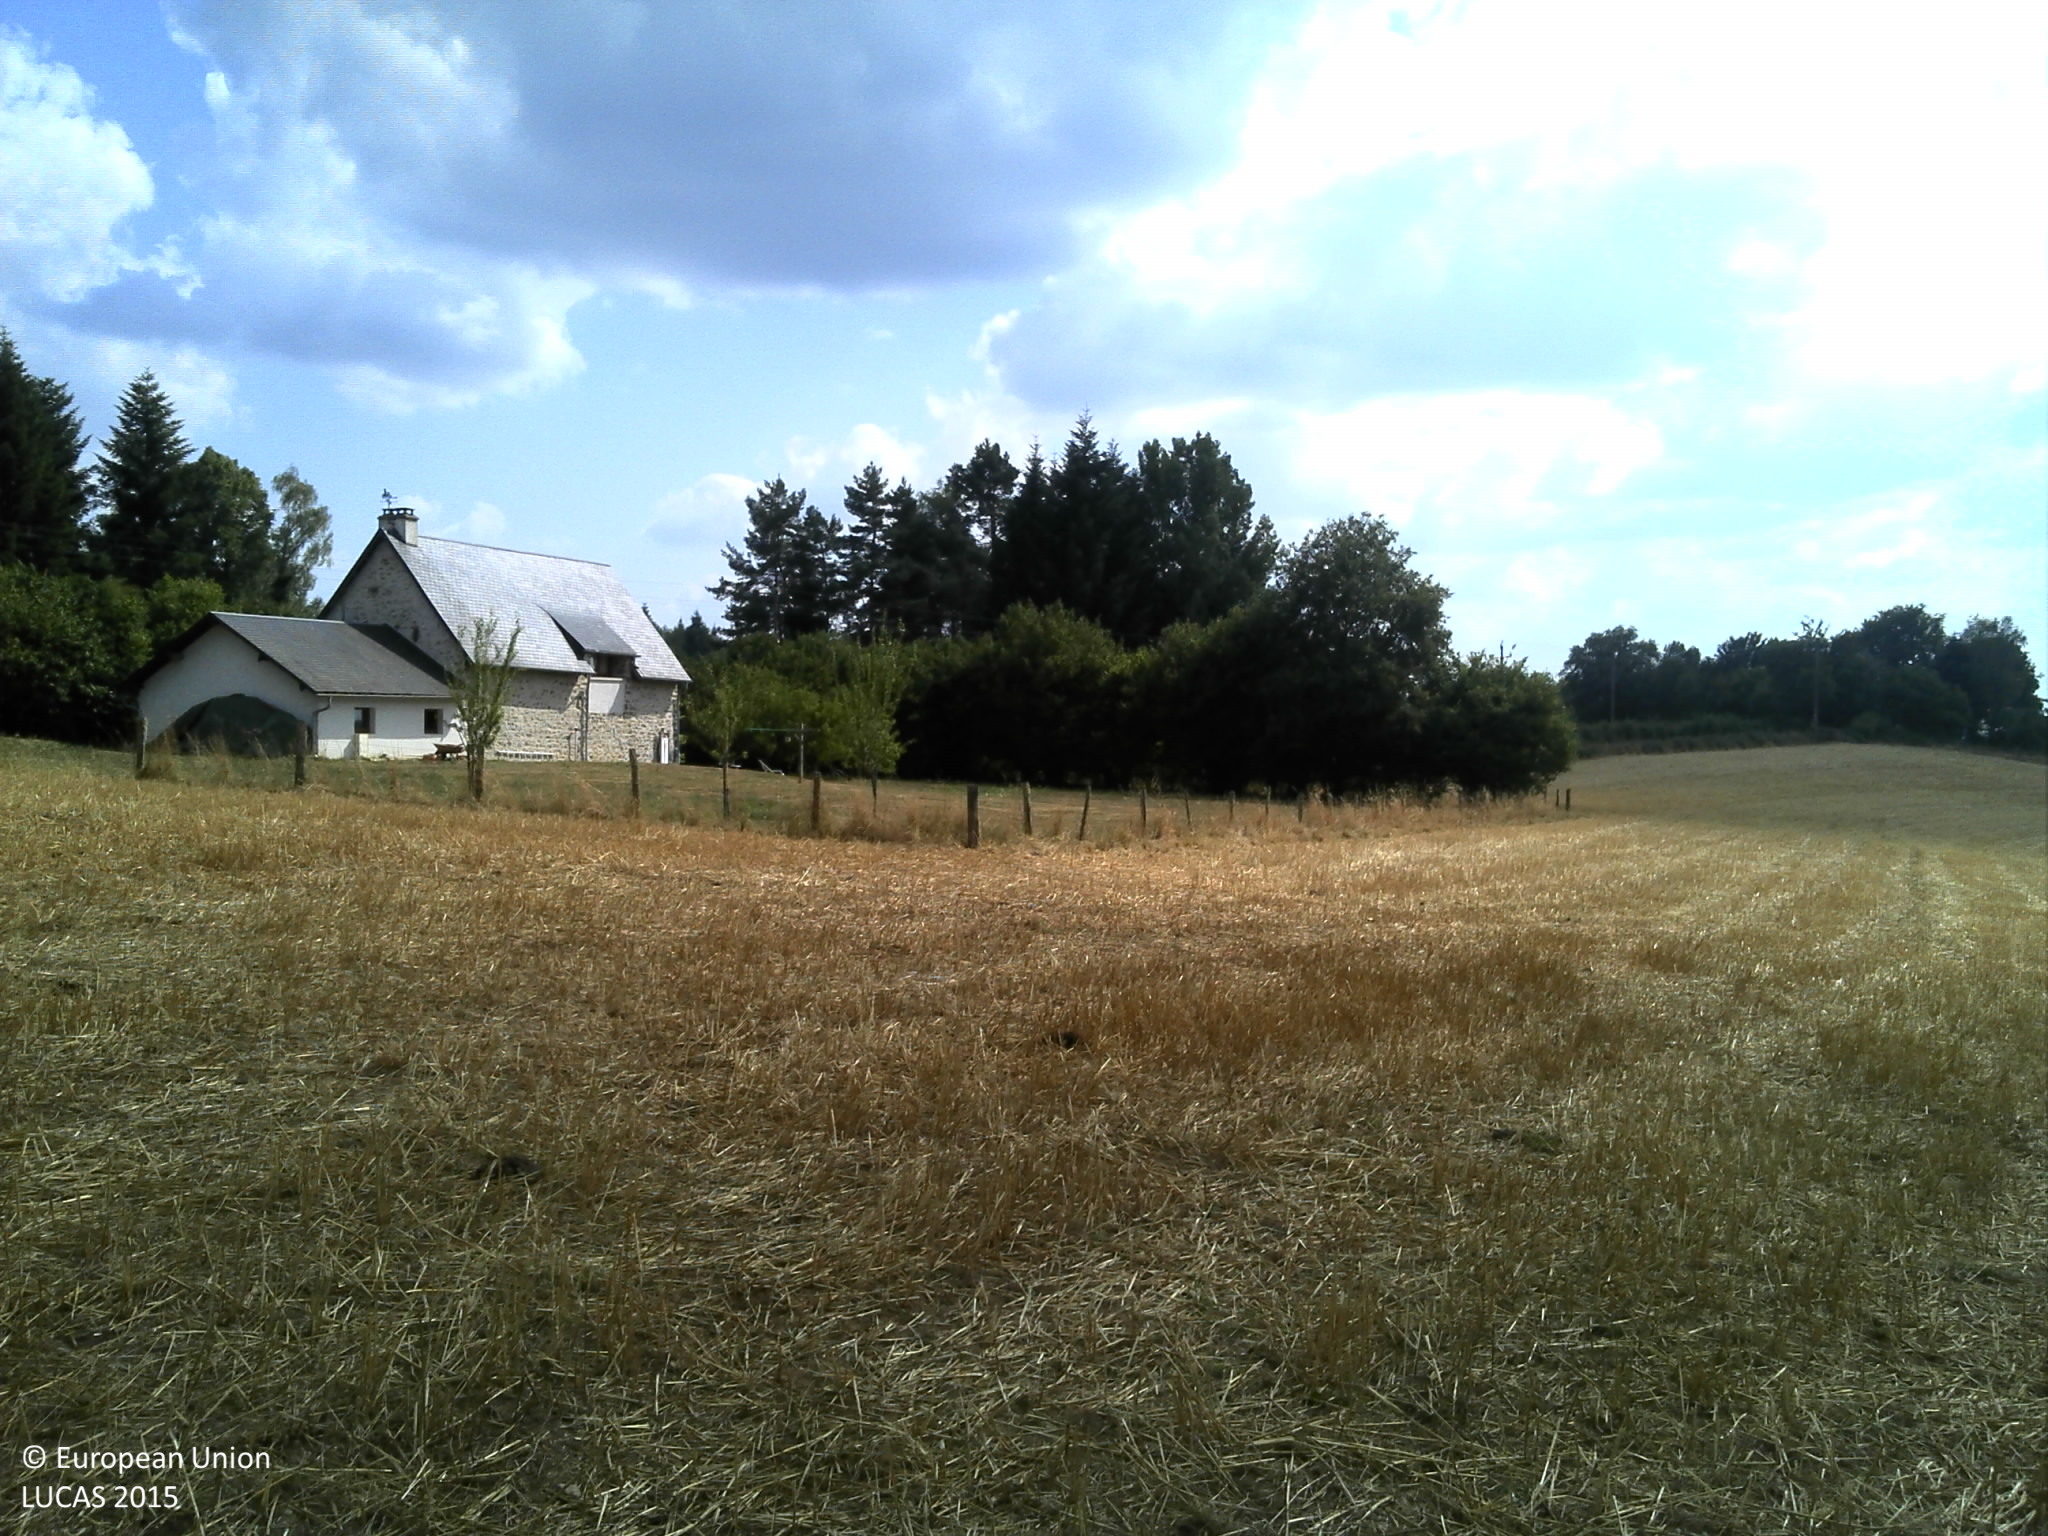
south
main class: Cropland
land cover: Common wheat
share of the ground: > 75 %
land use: Agriculture (excluding fallow land and kitchen gardens)
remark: Harvested field
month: August
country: FR
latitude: 45.5202
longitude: 2.4063
